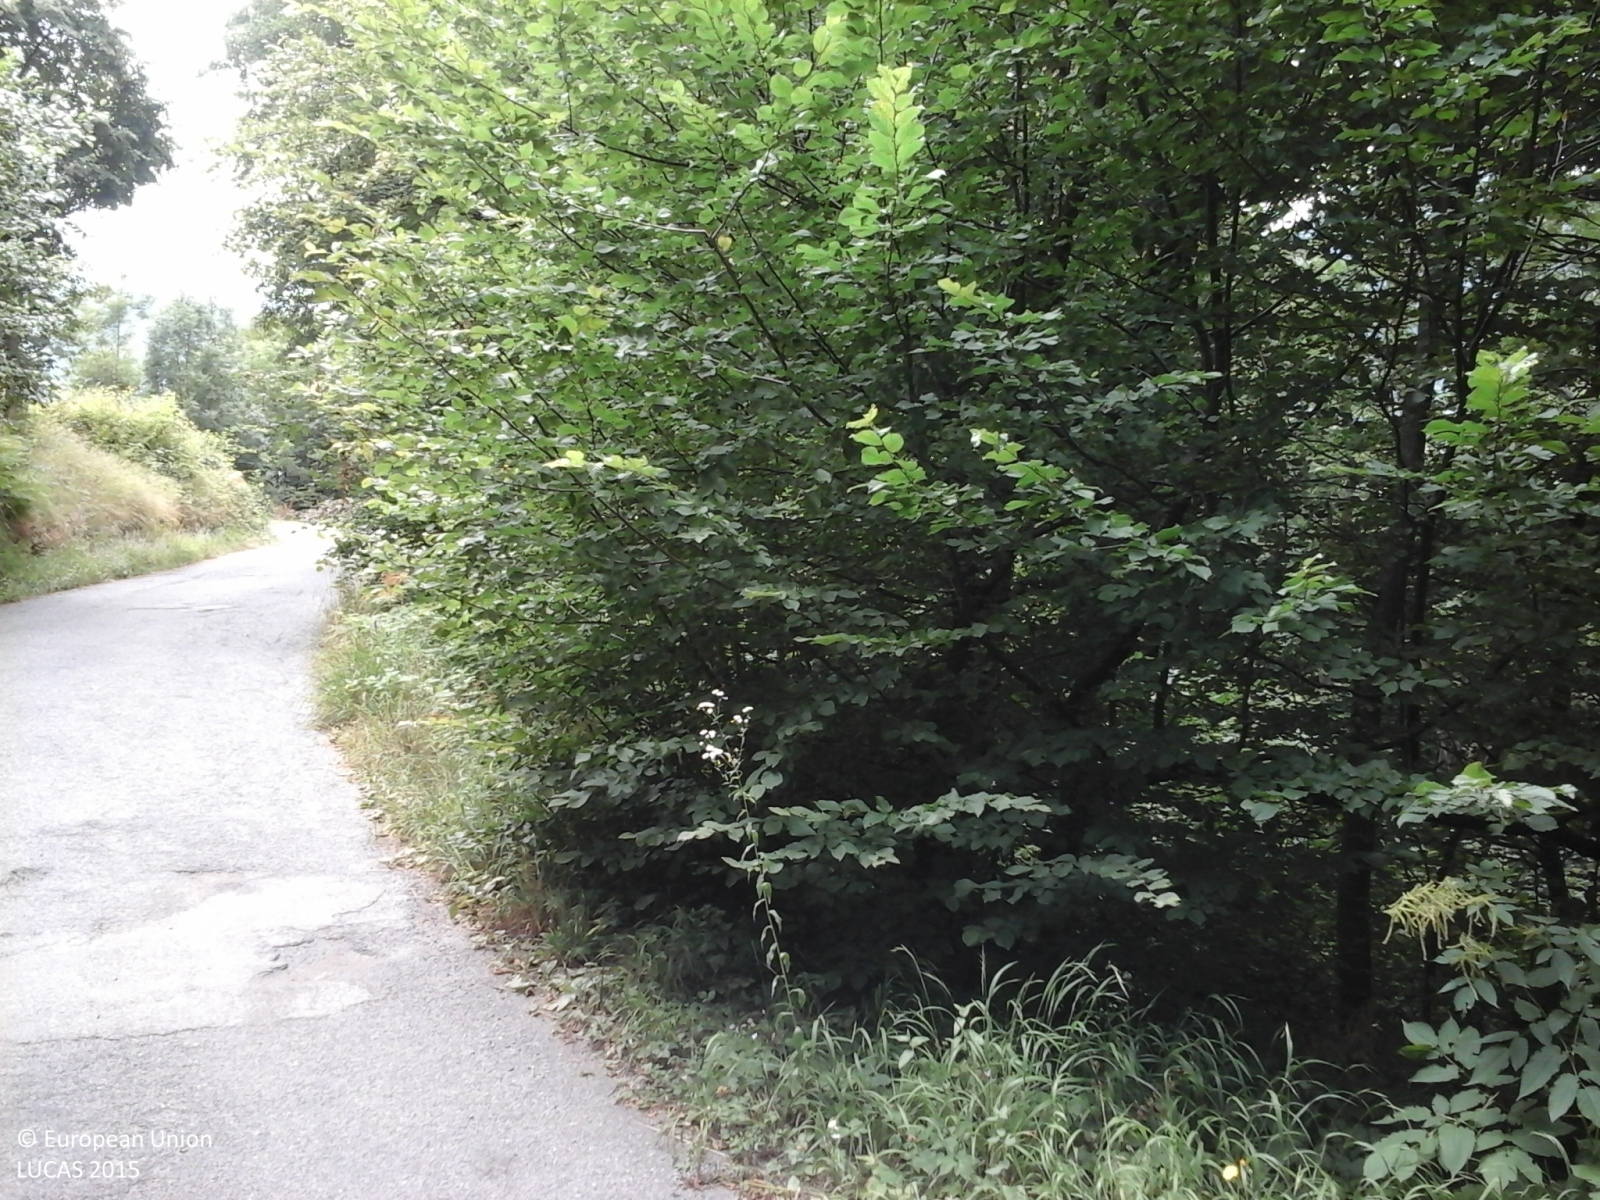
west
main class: Woodland
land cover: Broadleaved woodland
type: beech forest
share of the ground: > 75 %
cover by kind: broadleaved forest trees 100 %
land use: Semi-natural and natural areas not in use
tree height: > 5 m
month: July
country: IT
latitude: 44.9097
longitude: 7.2563
